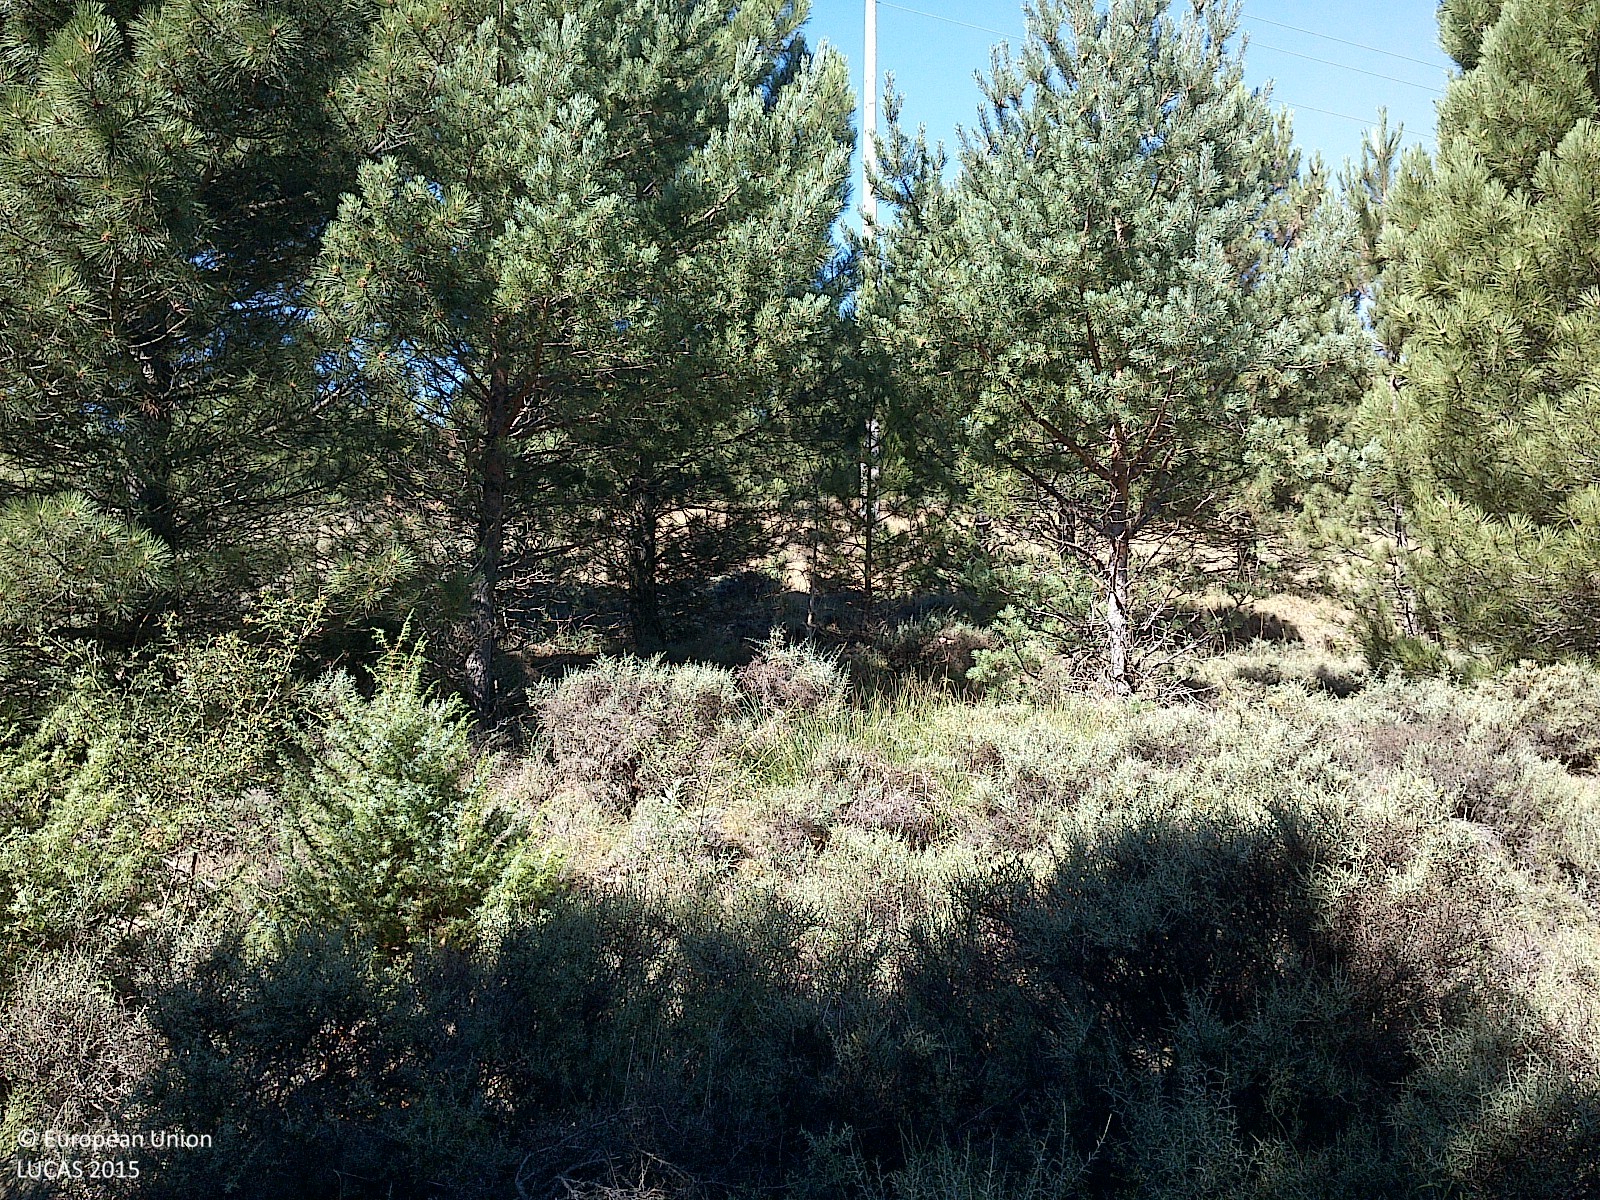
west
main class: Woodland
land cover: Pine dominated coniferous woodland
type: coniferous forest of the mediterranean region
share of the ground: 25 - 50 %
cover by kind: shrubs 55 %, coniferous forest trees 35 %, herbaceous plants 10 %
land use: Forestry
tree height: < 5 m
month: July
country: ES
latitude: 41.9668
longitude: -2.2123
